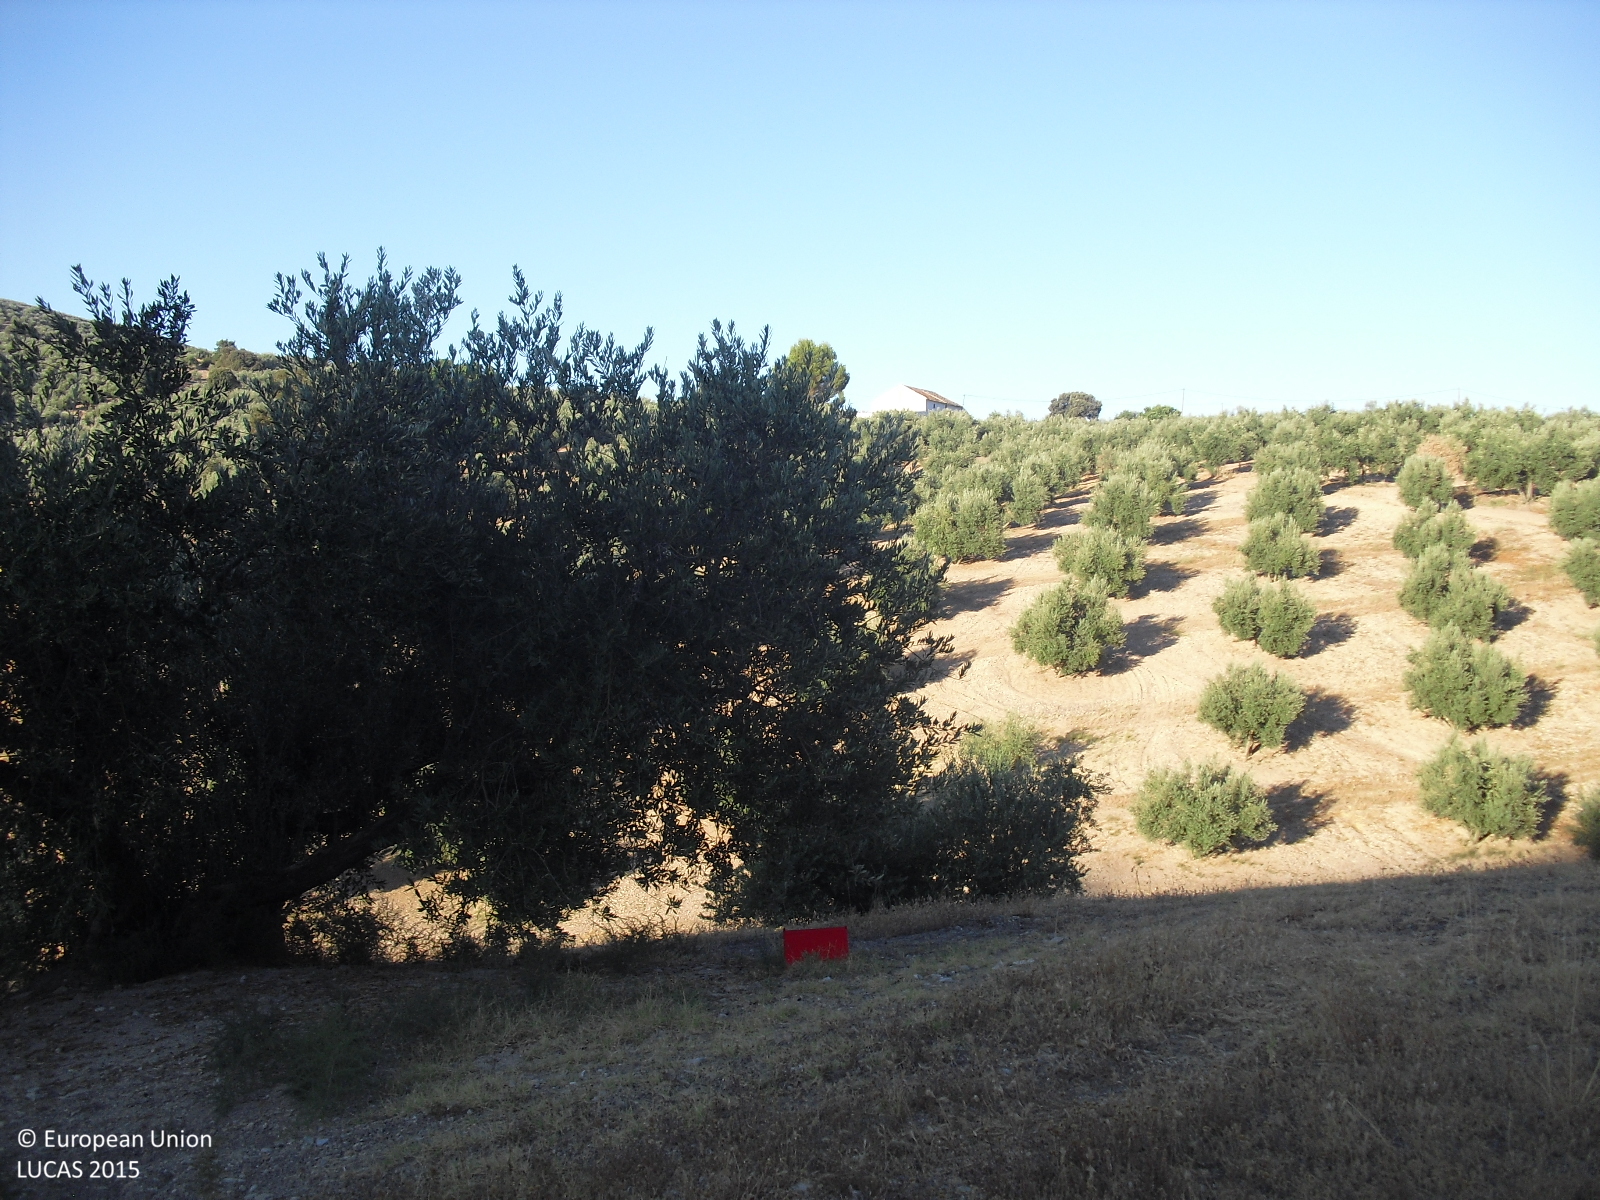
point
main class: Cropland
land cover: Olive groves
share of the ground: 10 - 25 %
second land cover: Spontaneously vegetated surfaces
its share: 25 - 50 %
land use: Agriculture (excluding fallow land and kitchen gardens)
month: August
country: ES
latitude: 37.2607
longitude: -4.1015
